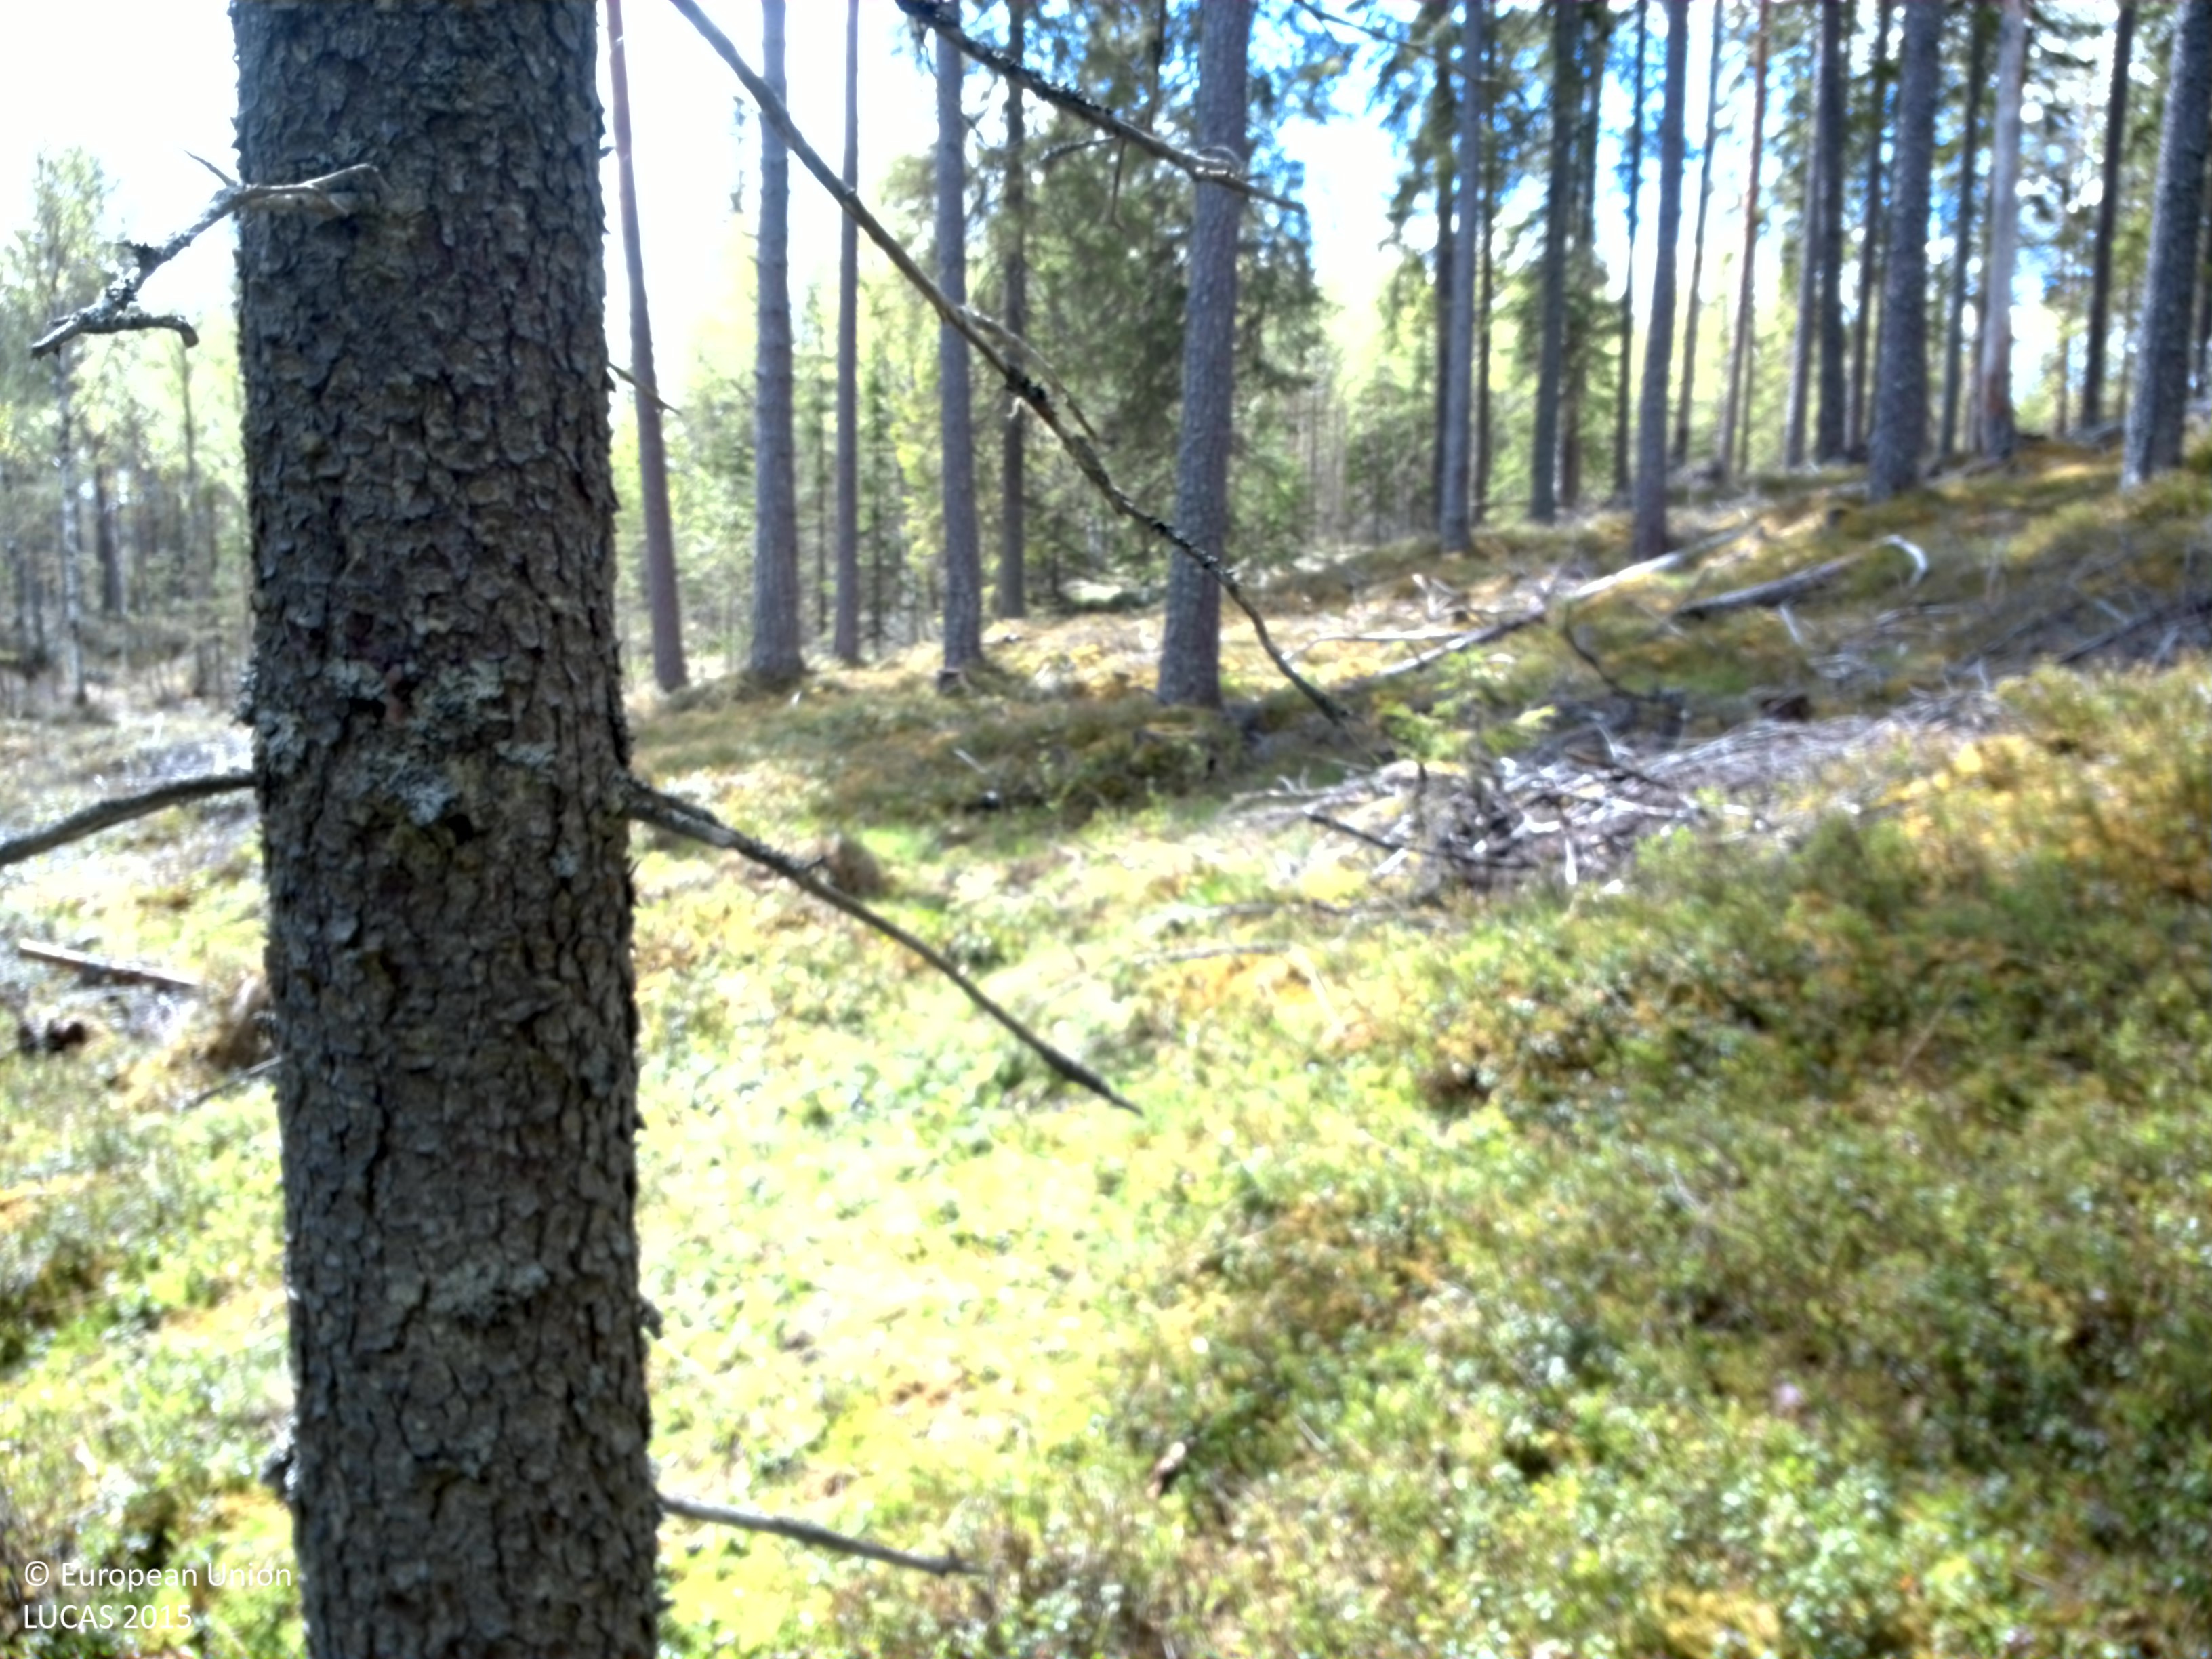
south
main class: Woodland
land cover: Other coniferous woodland
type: boreal forest
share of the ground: 50 - 75 %
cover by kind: coniferous forest trees 70 %, shrubs 30 %
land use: Forestry
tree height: > 5 m
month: May
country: SE
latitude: 60.3718
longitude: 13.4899
